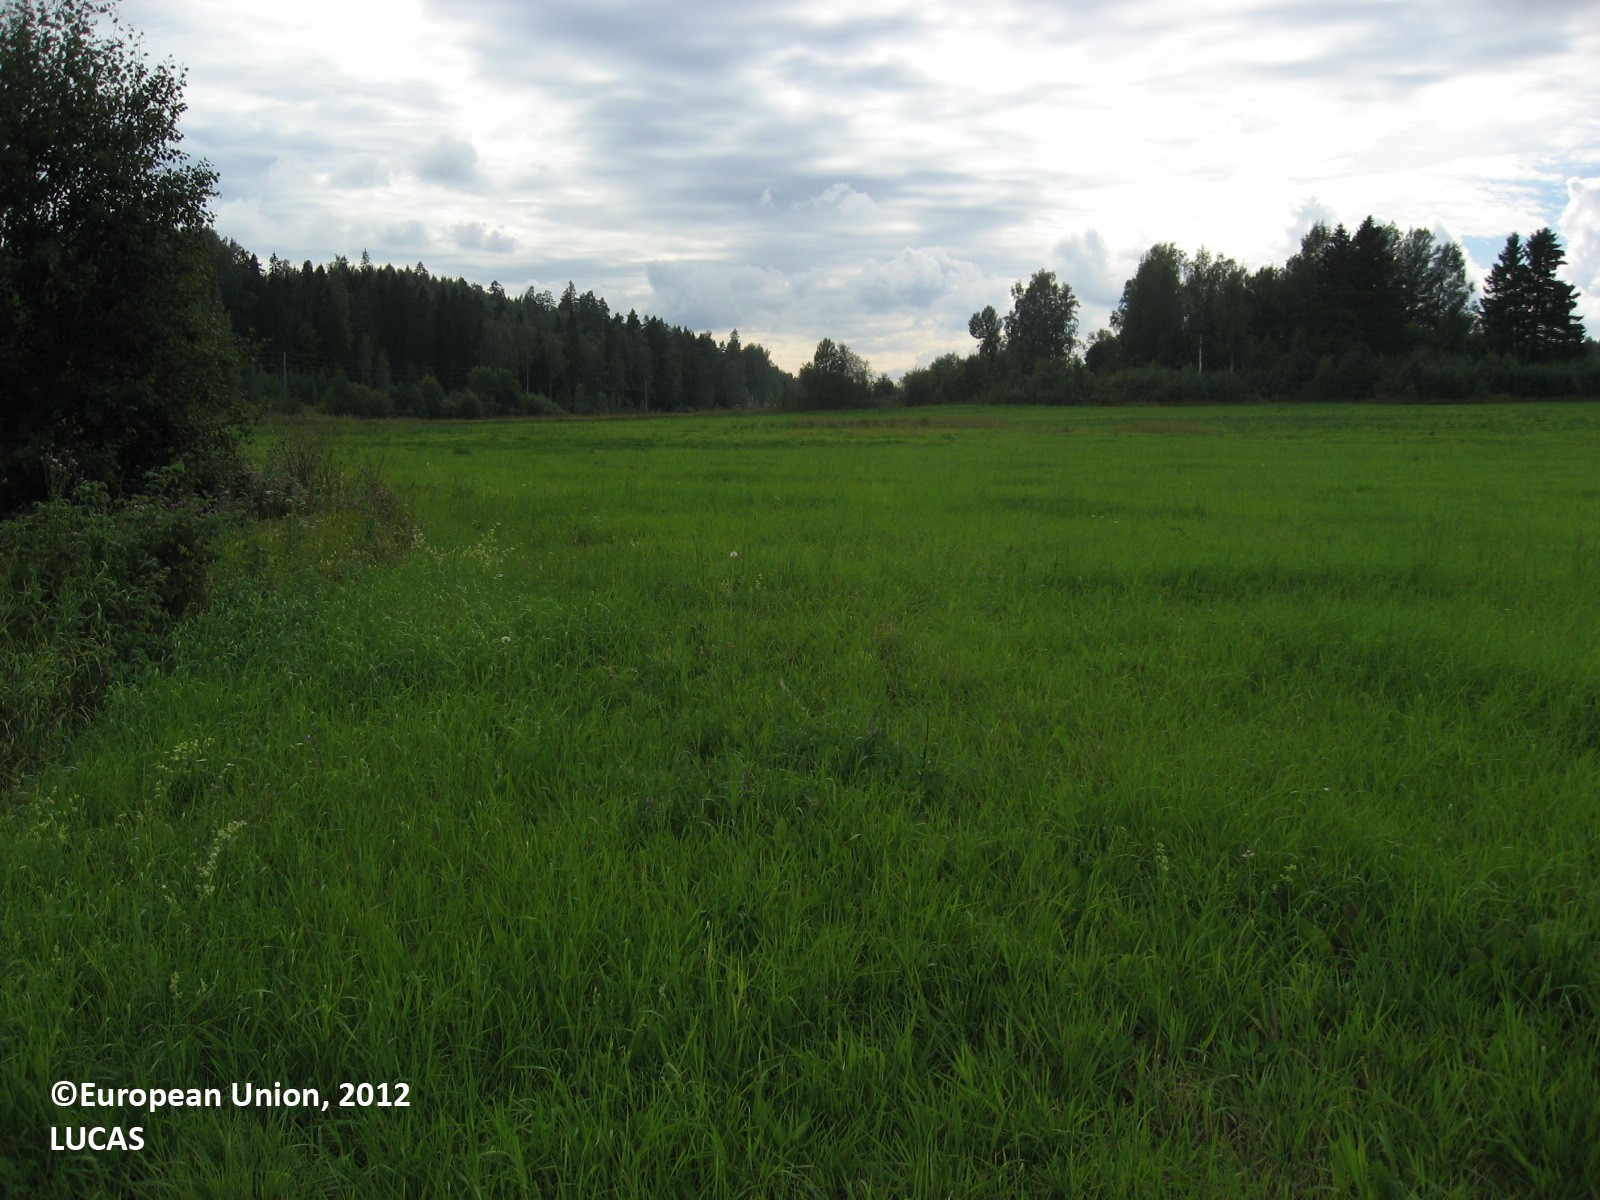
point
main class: Cropland
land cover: Temporary grasslands
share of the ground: > 75 %
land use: Agriculture (excluding fallow land and kitchen gardens)
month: August
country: FI
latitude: 60.3858
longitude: 25.3102
